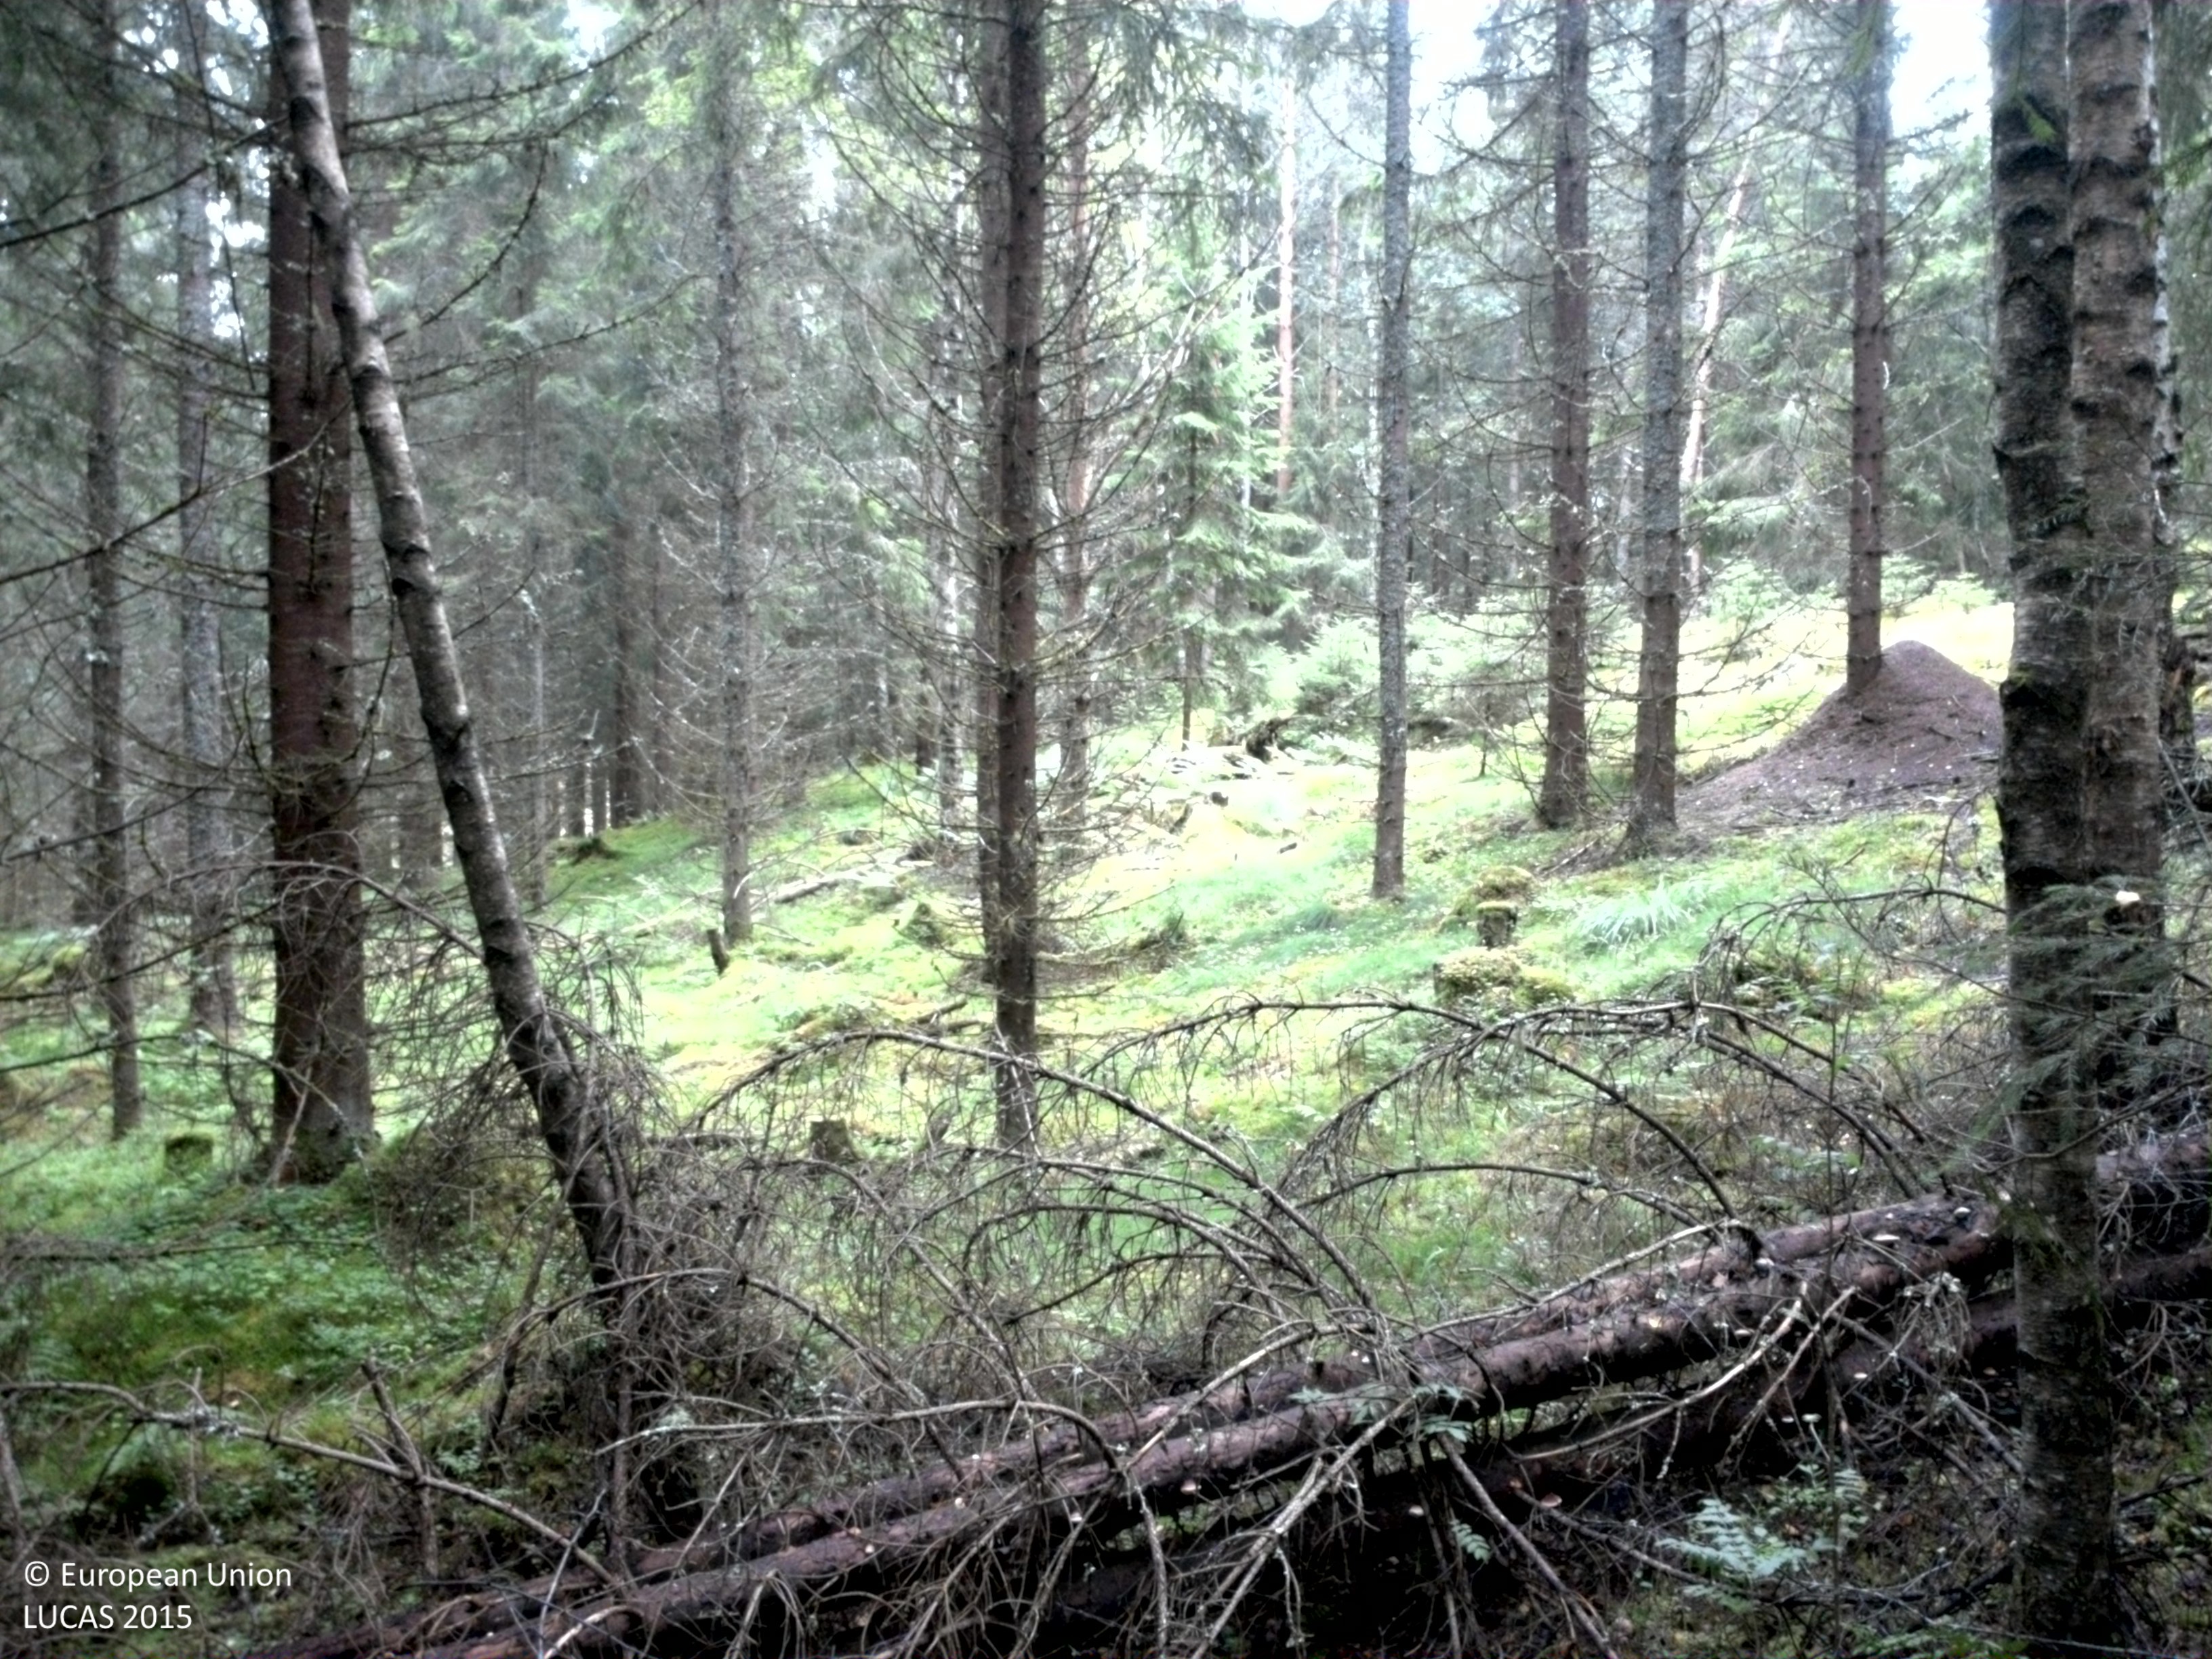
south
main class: Woodland
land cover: Spruce dominated coniferous woodland
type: boreal forest
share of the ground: 50 - 75 %
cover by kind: coniferous forest trees 65 %, lichens and mosses 20 %, broadleaved forest trees 5 %, shrubs 5 %, herbaceous plants 5 %
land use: Forestry
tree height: > 5 m
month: August
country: SE
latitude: 59.6219
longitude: 13.2009
